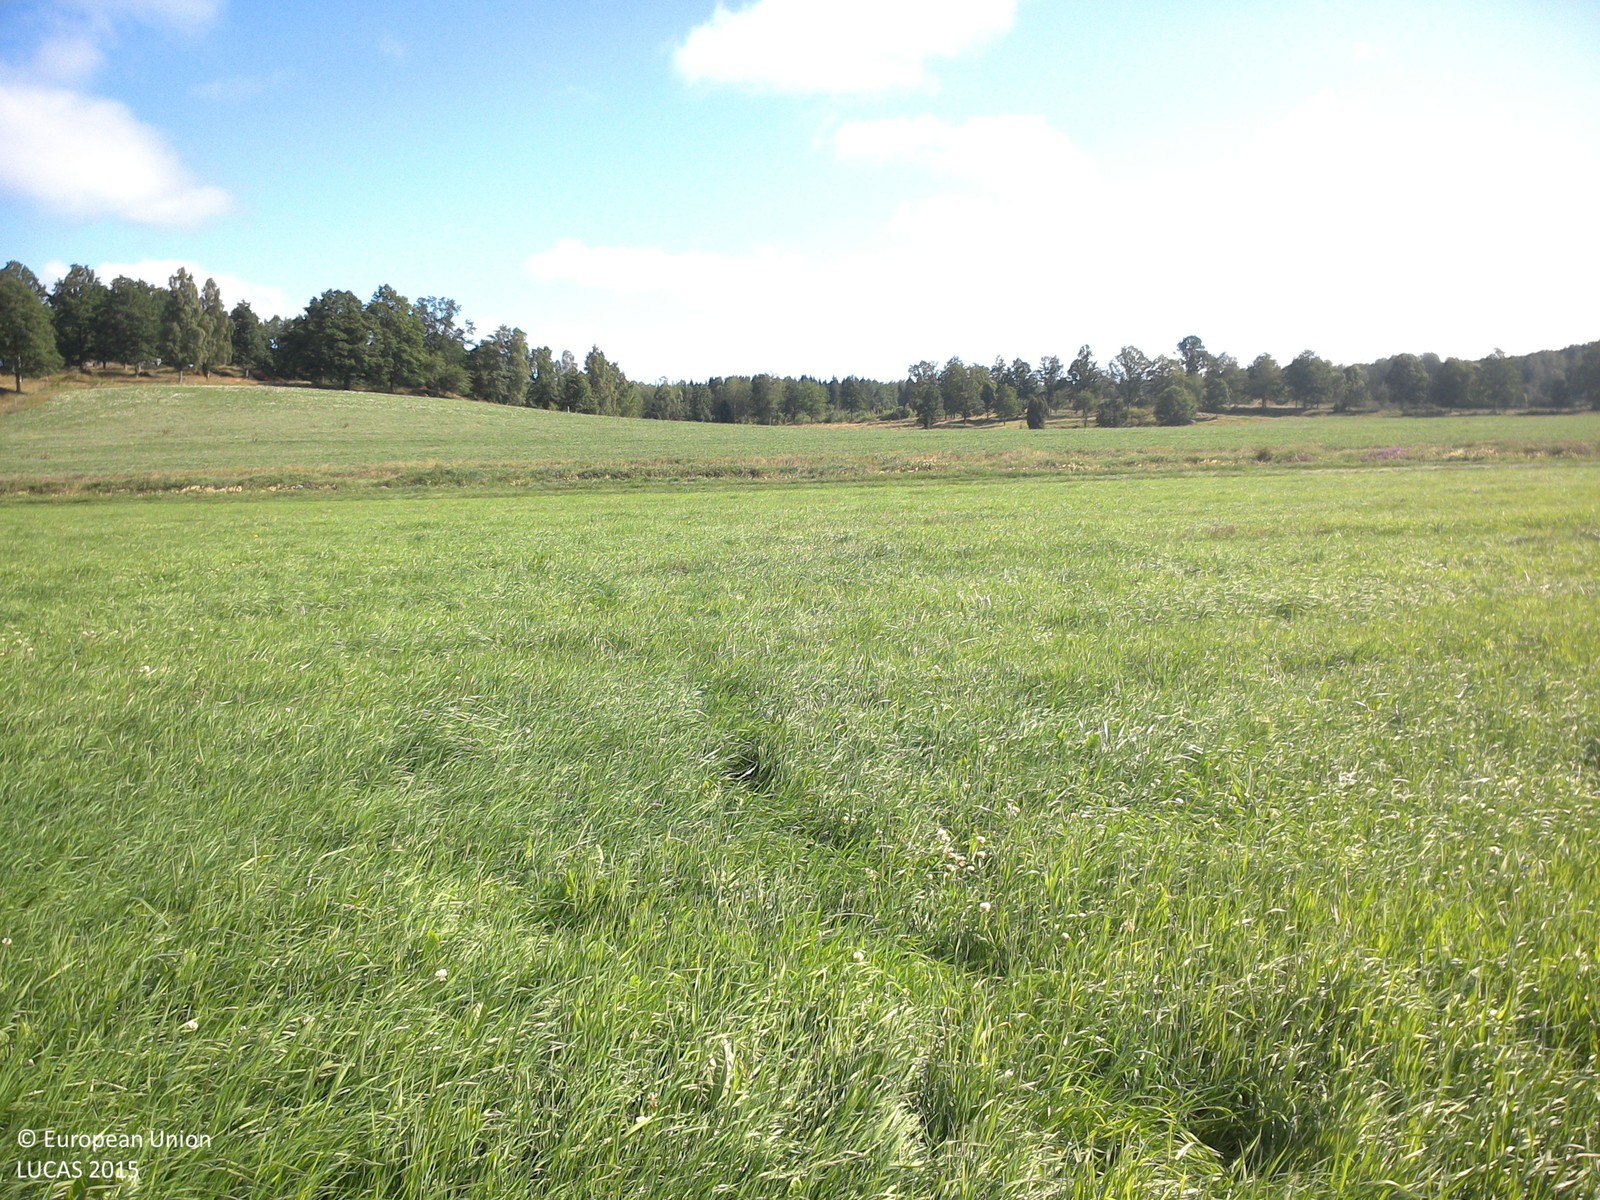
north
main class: Cropland
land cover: Other leguminous and mixtures for fodder
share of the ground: > 75 %
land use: Agriculture (excluding fallow land and kitchen gardens)
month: July
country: SE
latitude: 58.0046
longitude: 14.8851
